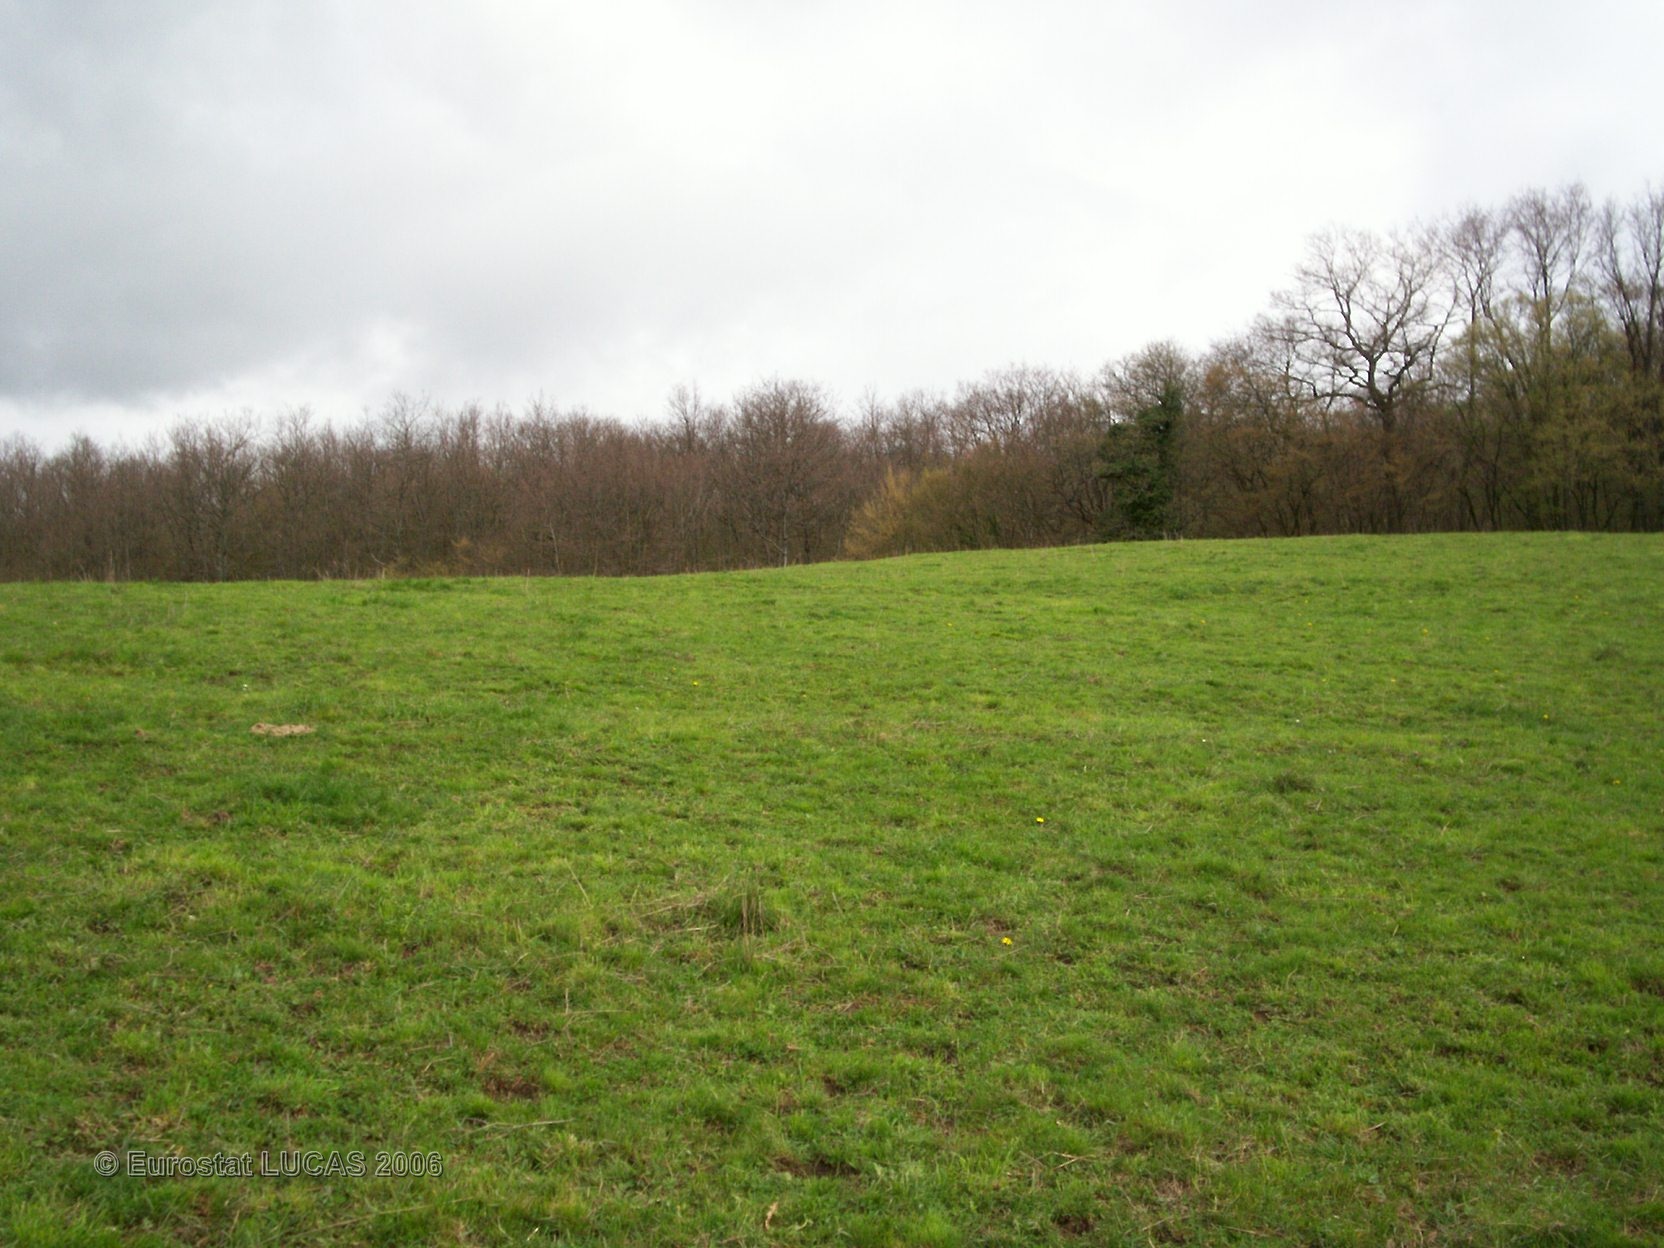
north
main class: Grassland
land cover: Grassland without tree/shrub cover
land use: Agriculture (excluding fallow land and kitchen gardens)
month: April
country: FR
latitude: 46.4174
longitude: 4.6805
